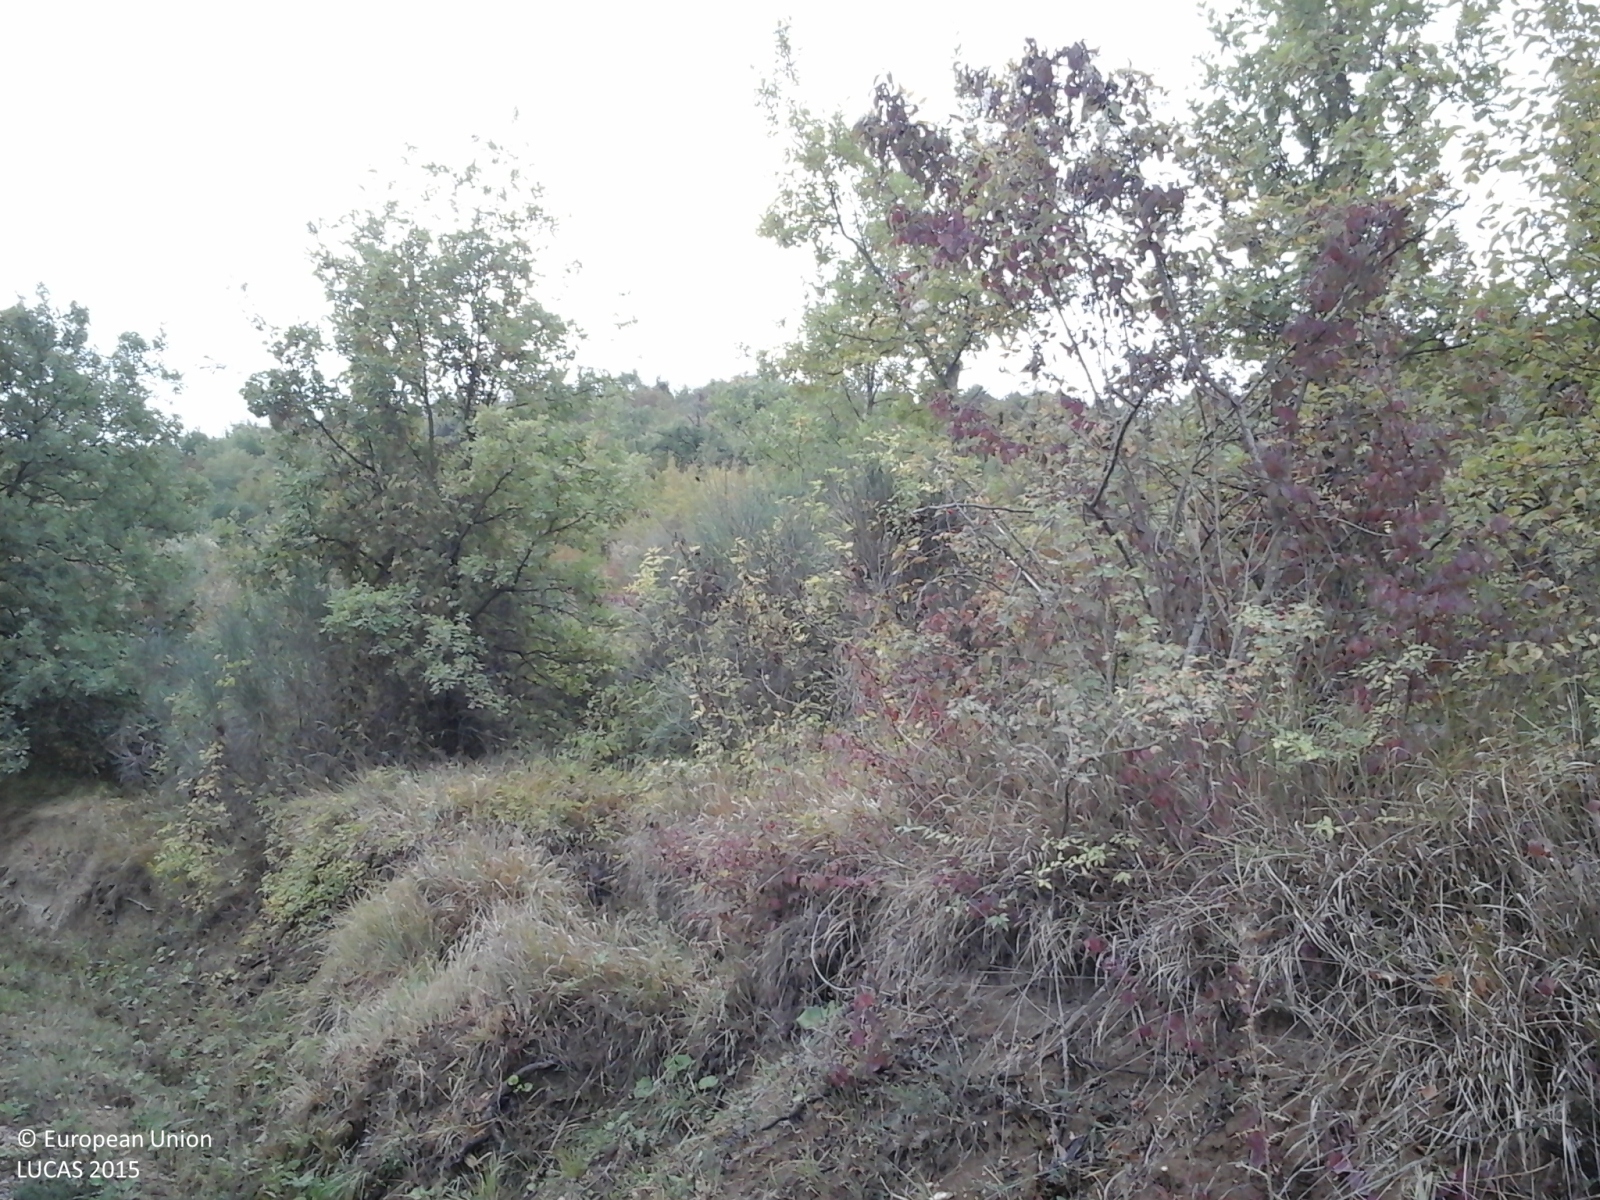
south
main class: Woodland
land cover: Broadleaved woodland
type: thermophilous deciduous forest
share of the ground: > 75 %
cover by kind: broadleaved forest trees 90 %, shrubs 10 %
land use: Forestry
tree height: > 5 m
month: October
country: IT
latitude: 43.1677
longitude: 12.3917
